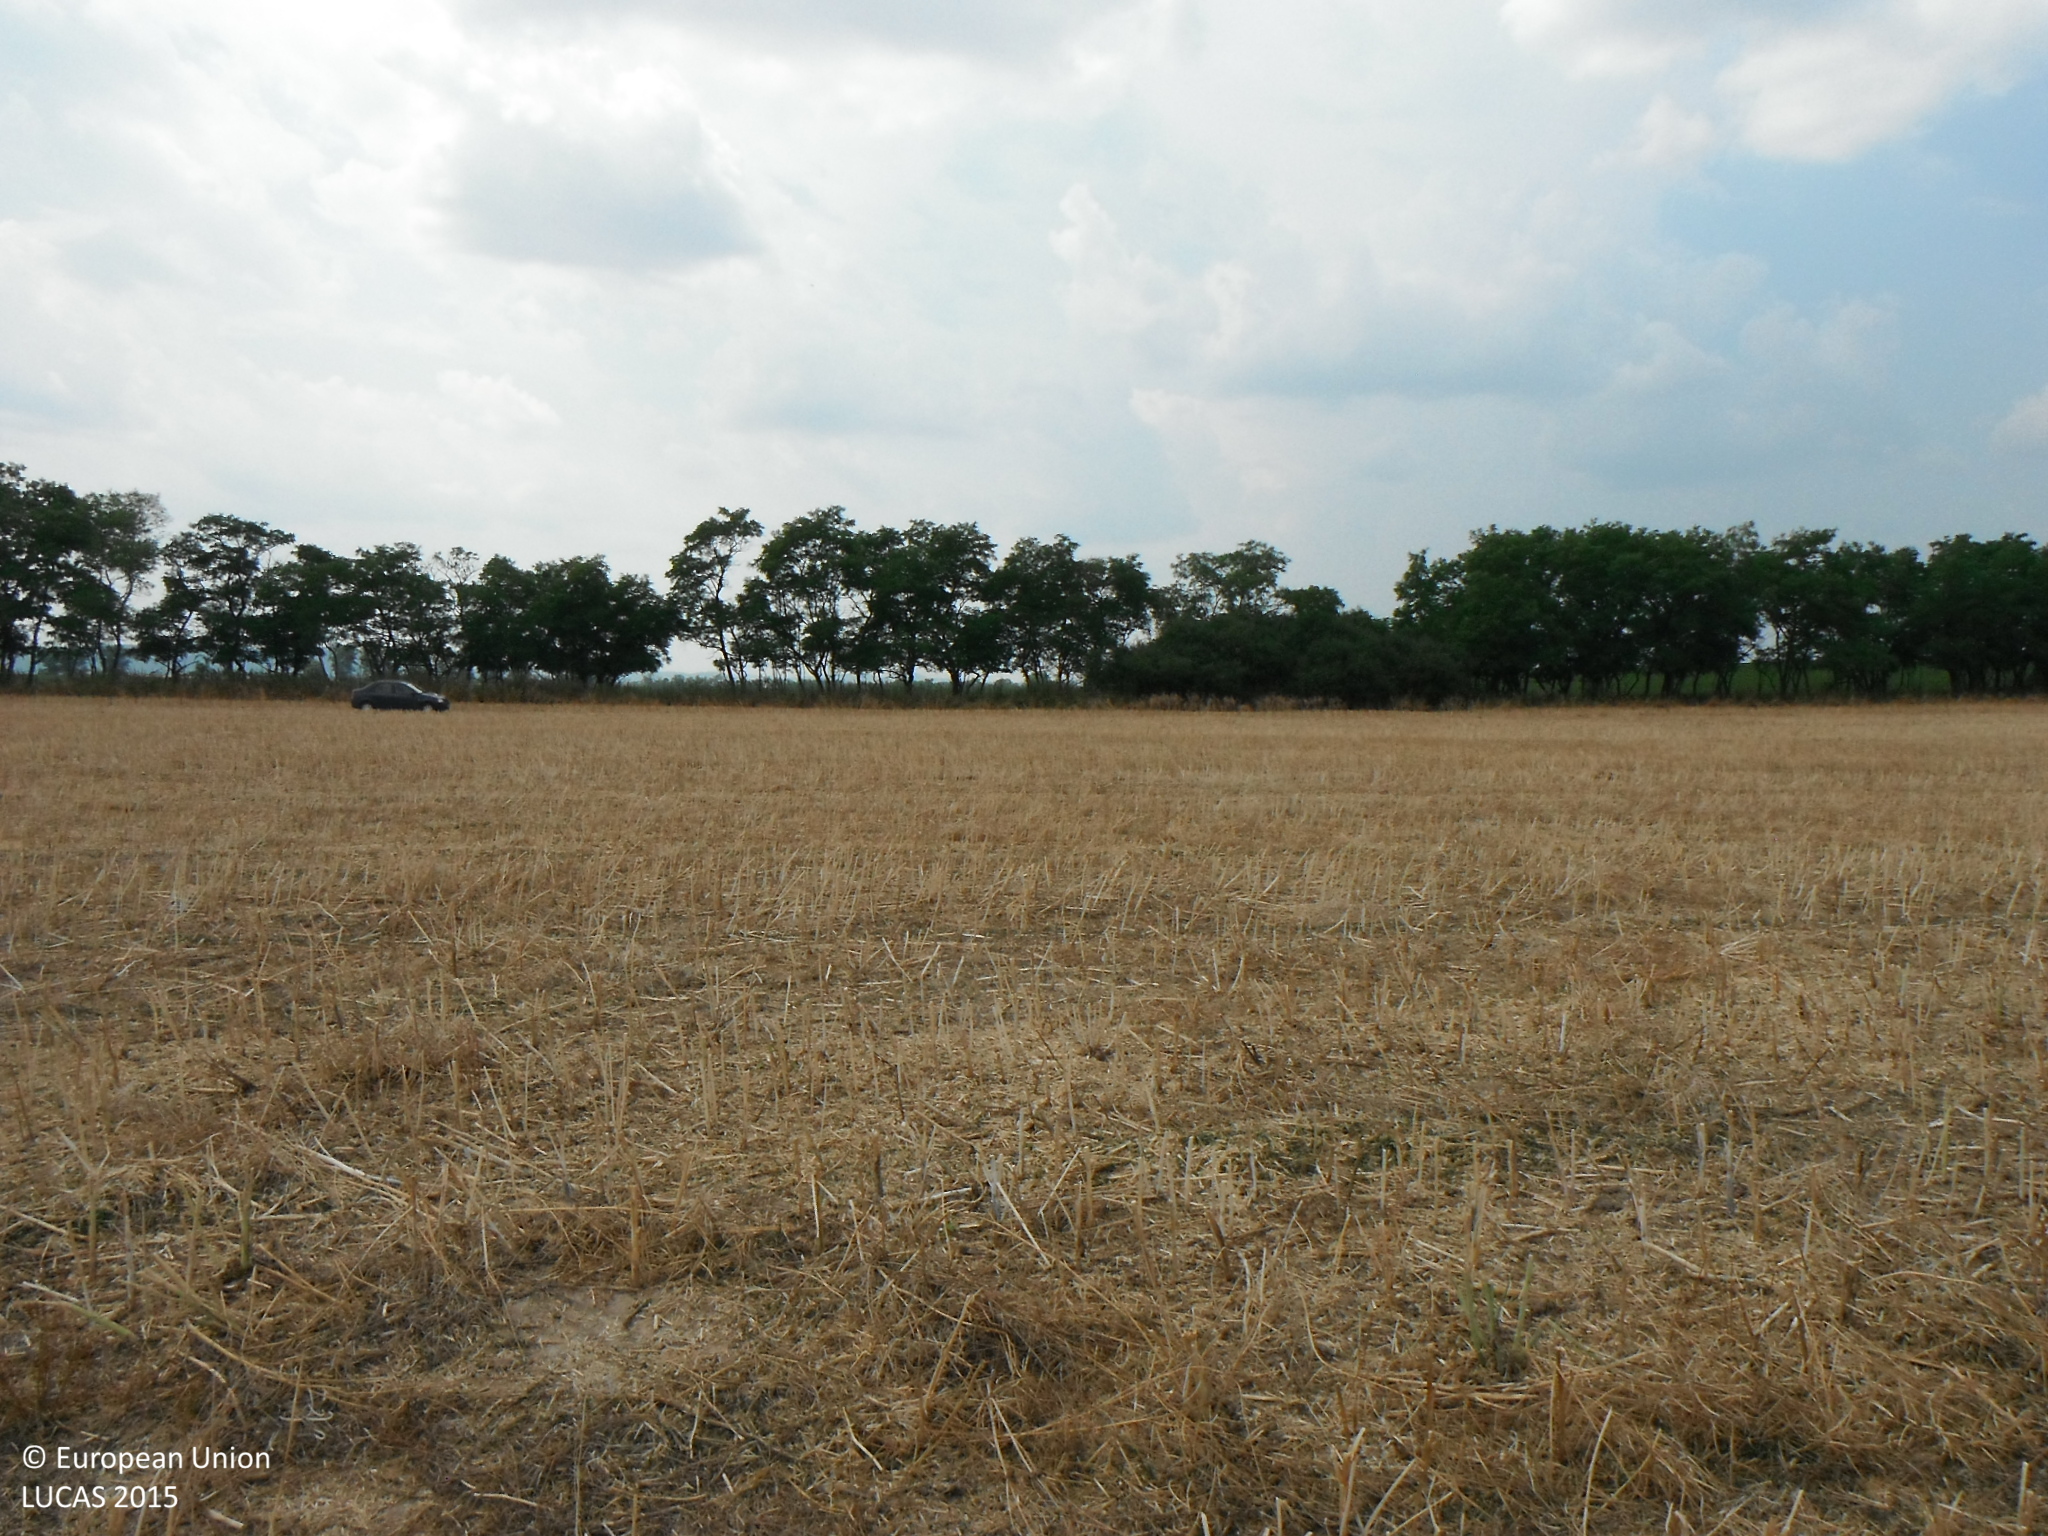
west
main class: Cropland
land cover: Rape and turnip rape
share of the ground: > 75 %
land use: Agriculture (excluding fallow land and kitchen gardens)
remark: Harvested field
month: July
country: SK
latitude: 48.3128
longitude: 20.1844
